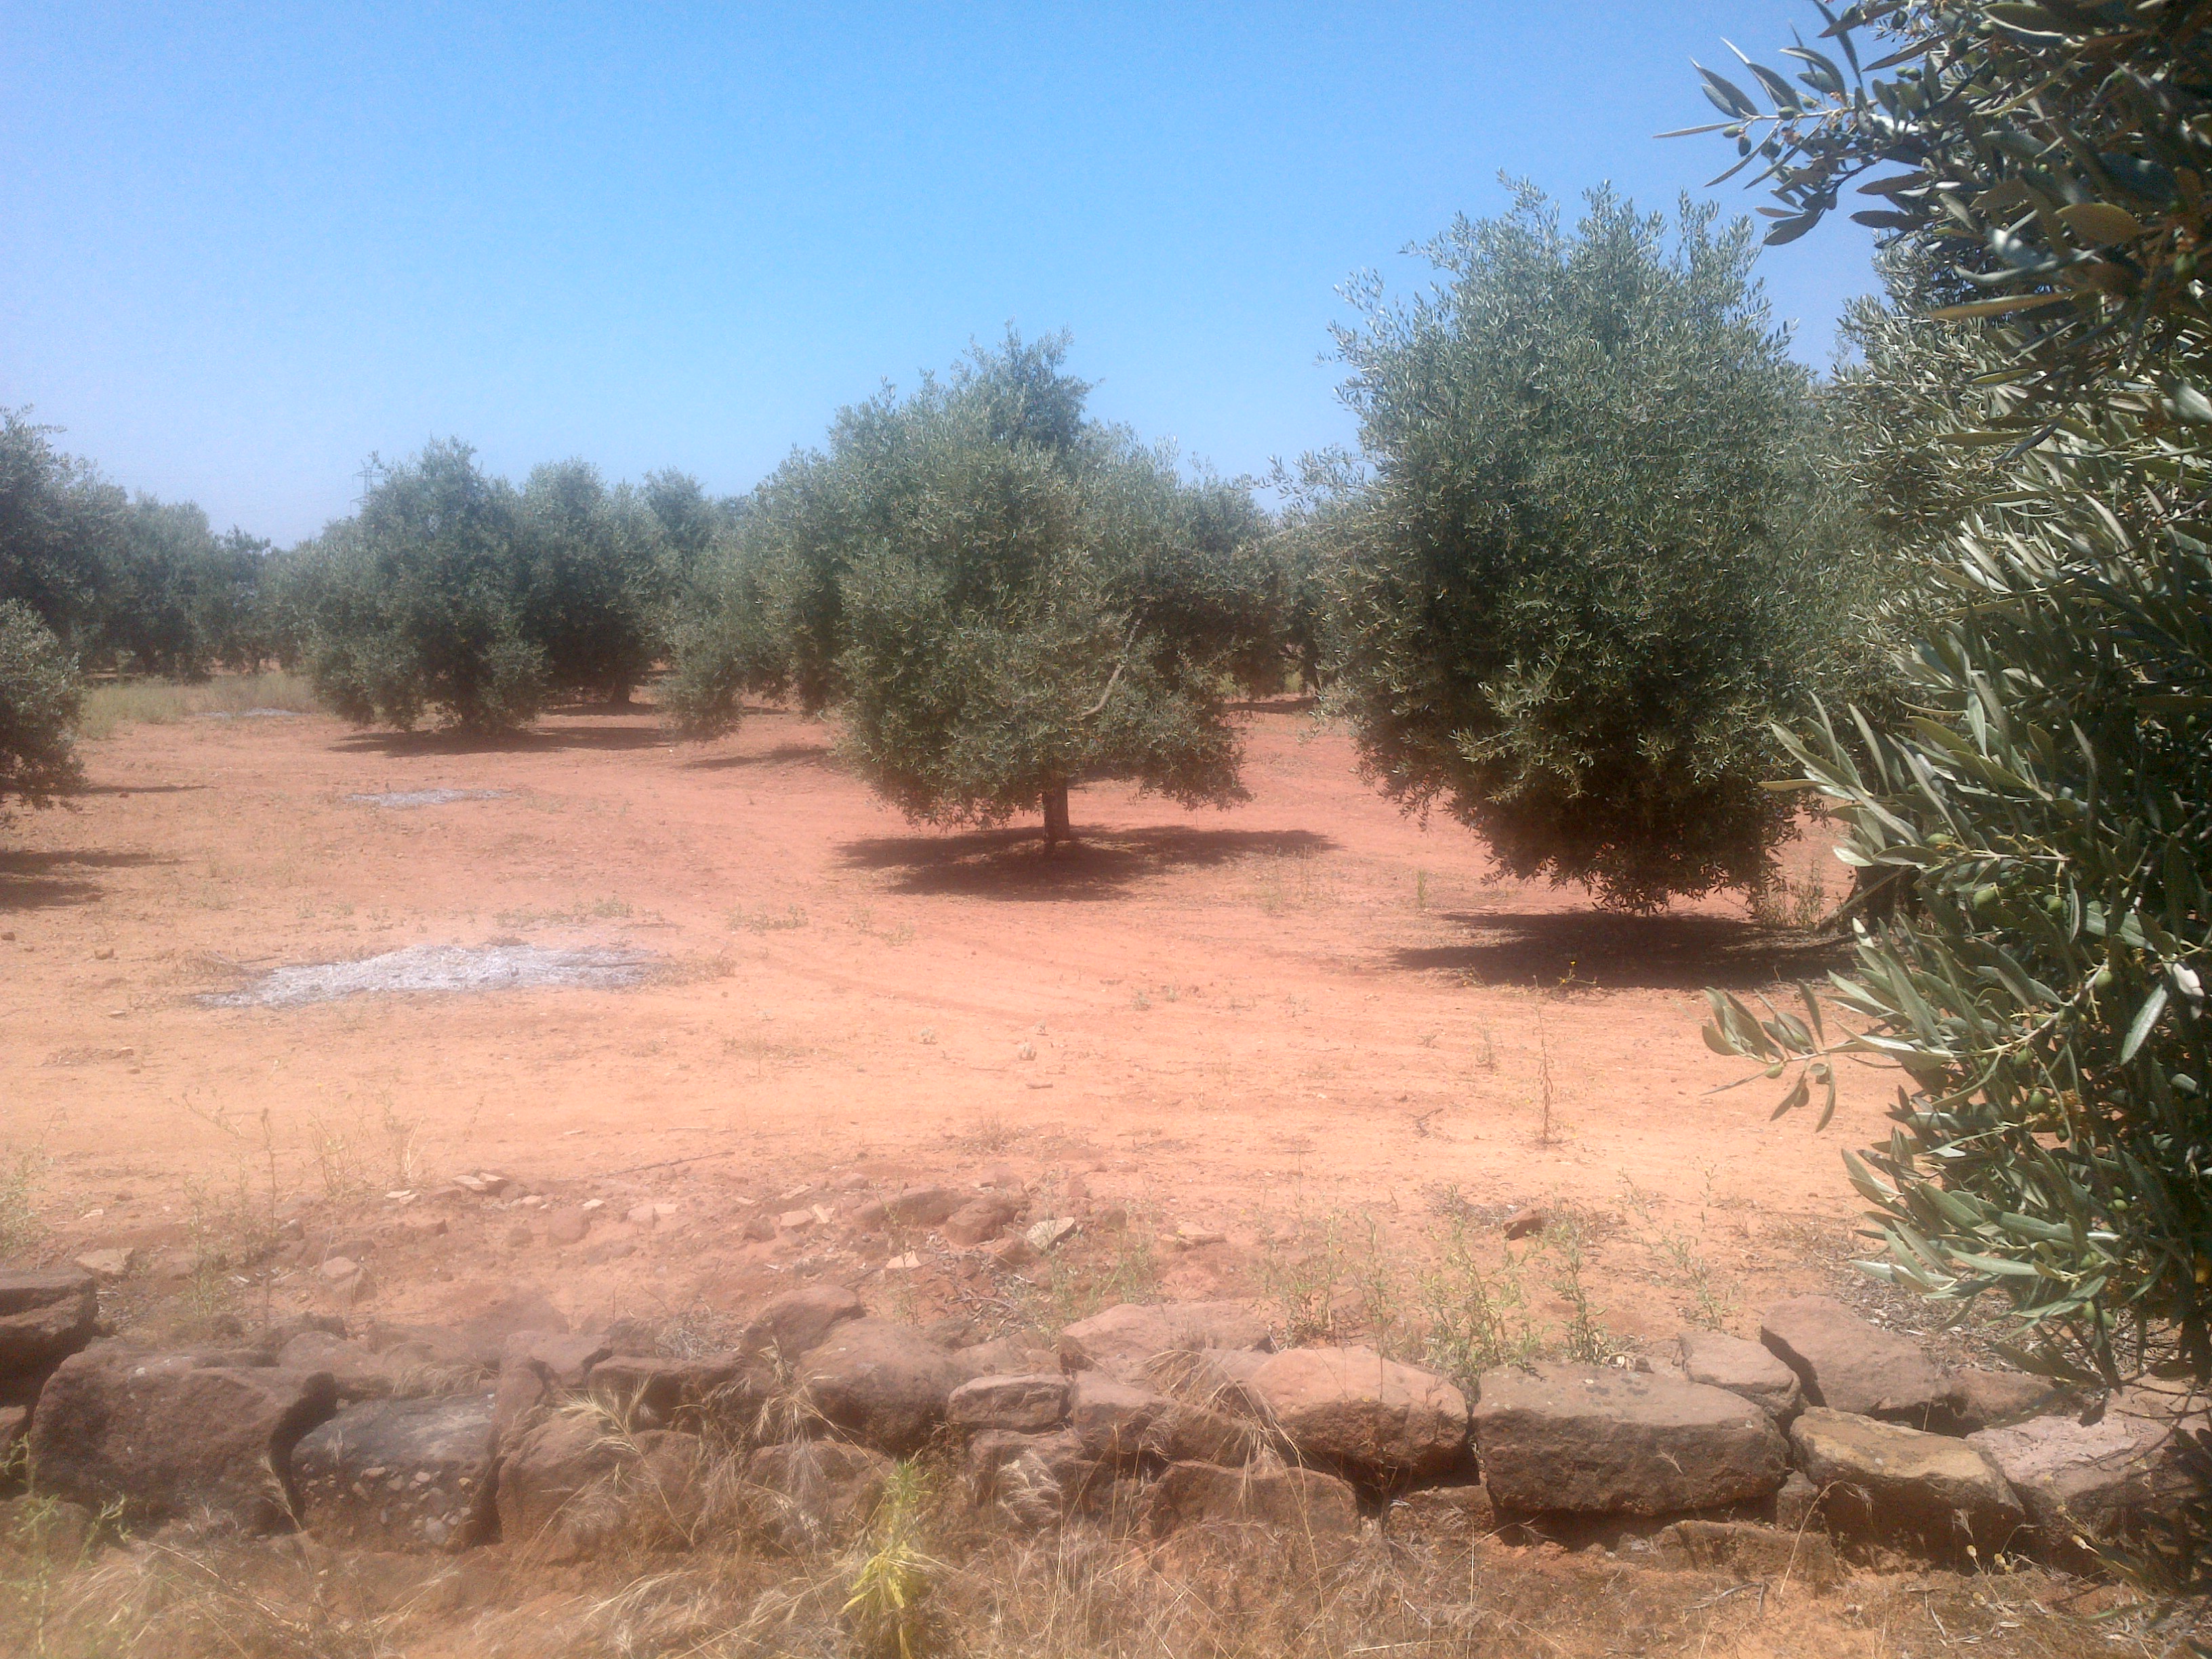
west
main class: Cropland
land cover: Olive groves
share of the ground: 50 - 75 %
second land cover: Spontaneously vegetated surfaces
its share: 10 - 25 %
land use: Agriculture (excluding fallow land and kitchen gardens)
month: June
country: ES
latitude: 38.0519
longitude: -4.3362
